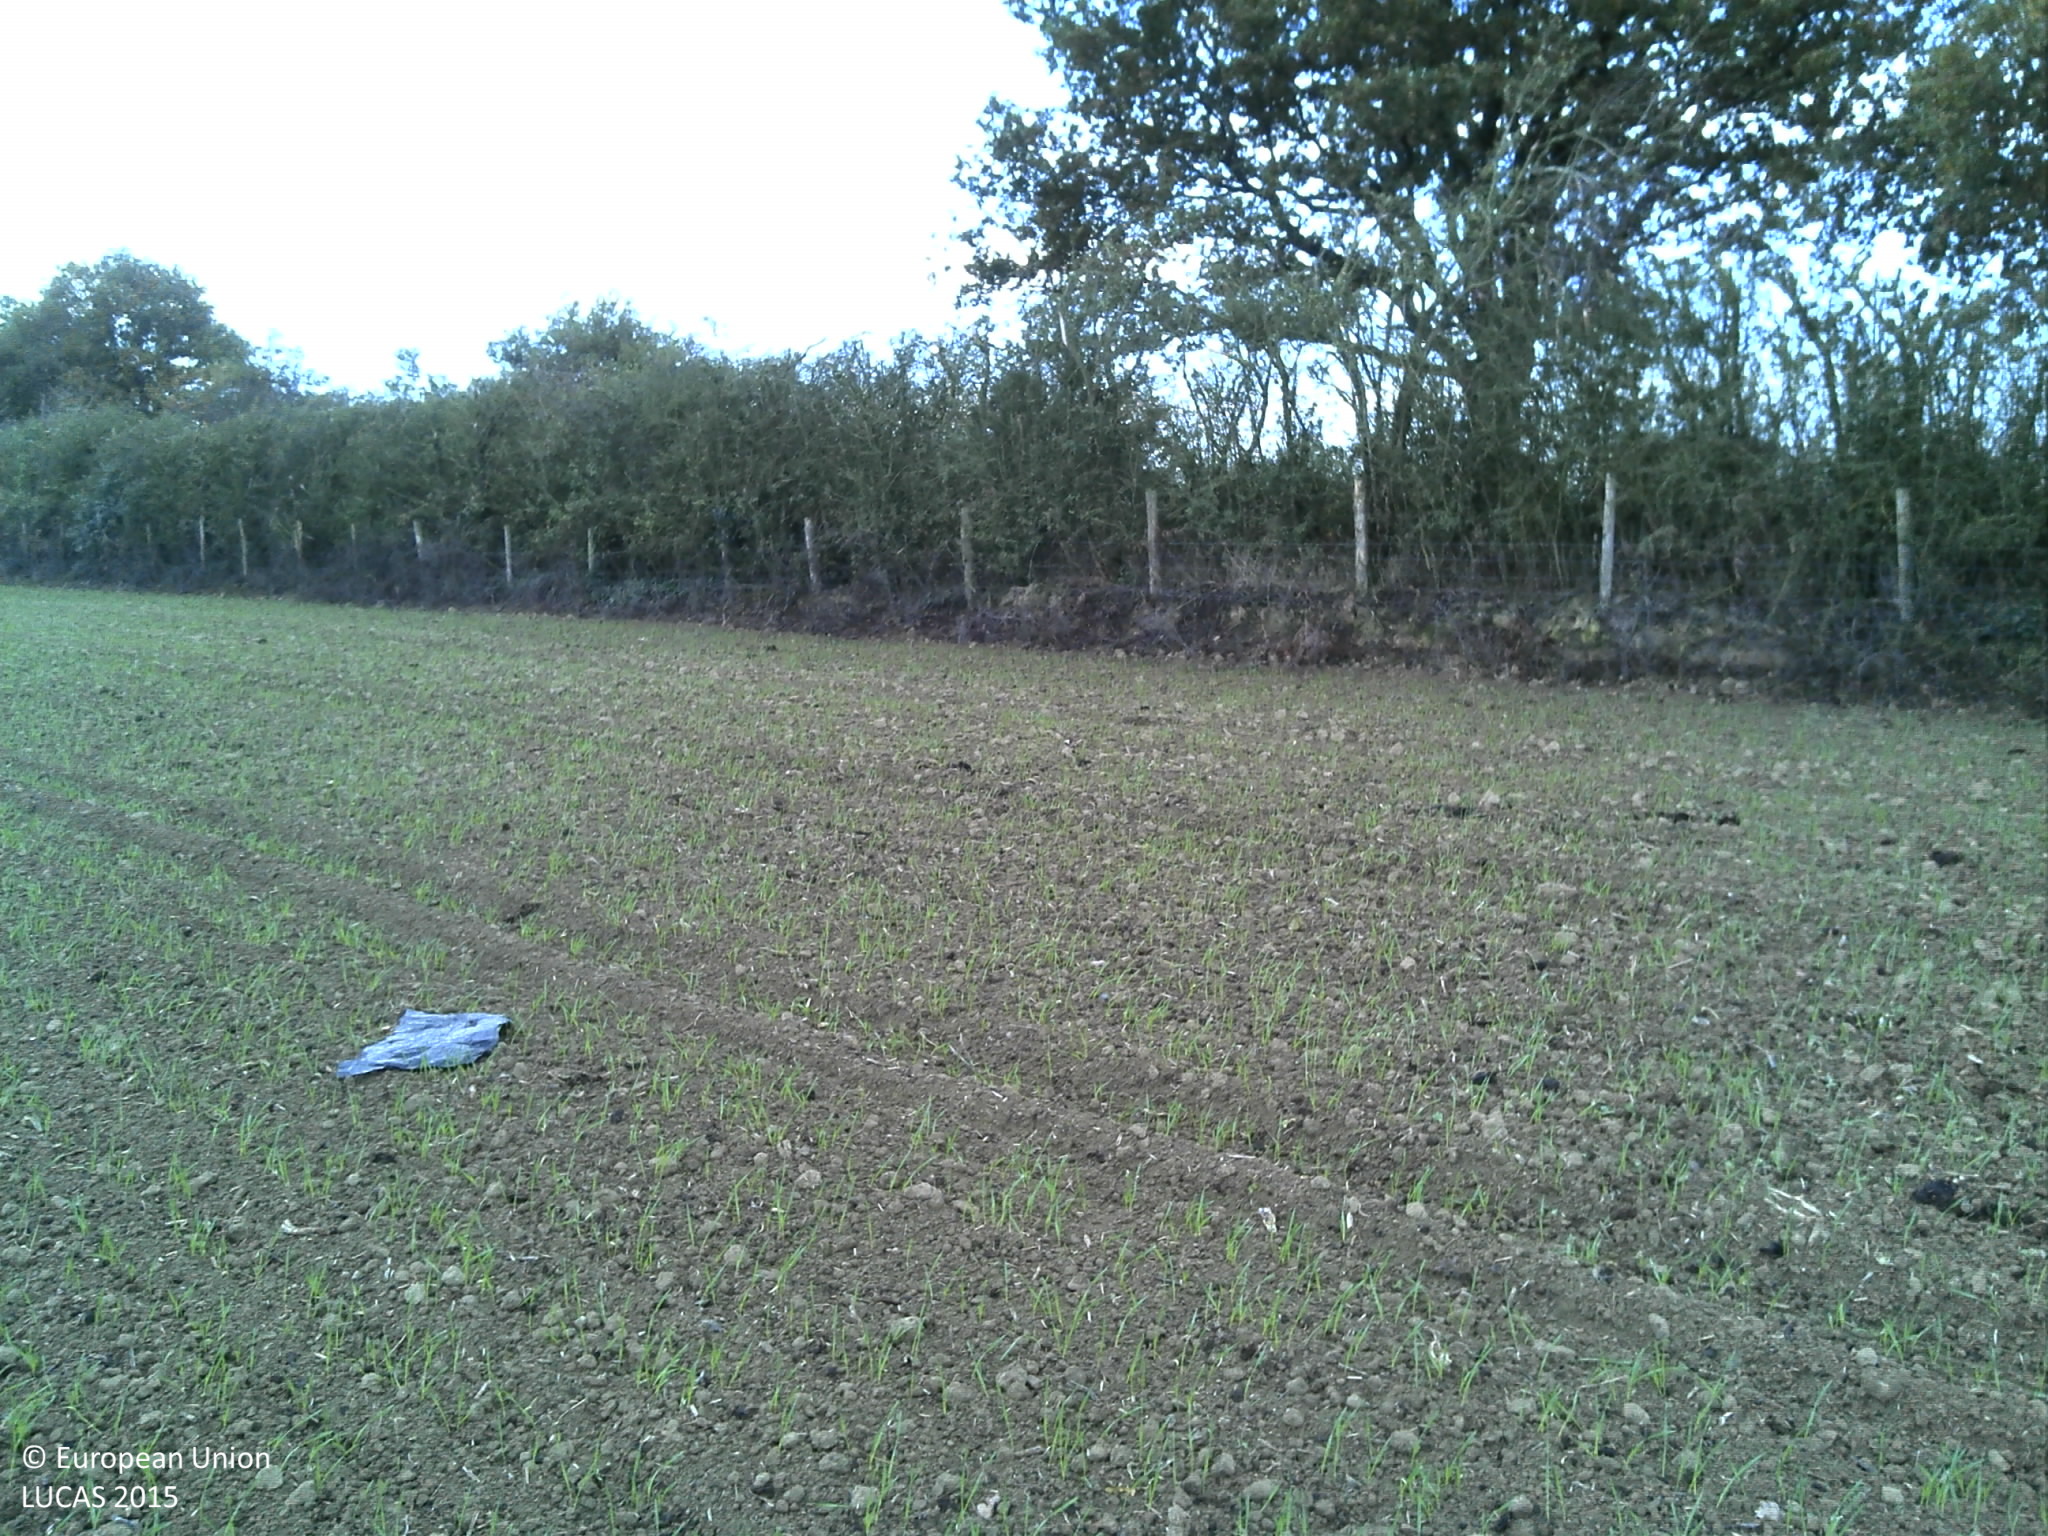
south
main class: Cropland
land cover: Common wheat
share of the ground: < 10 %
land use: Agriculture (excluding fallow land and kitchen gardens)
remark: Tilled/Sowed
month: November
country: FR
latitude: 47.6074
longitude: -1.0924
